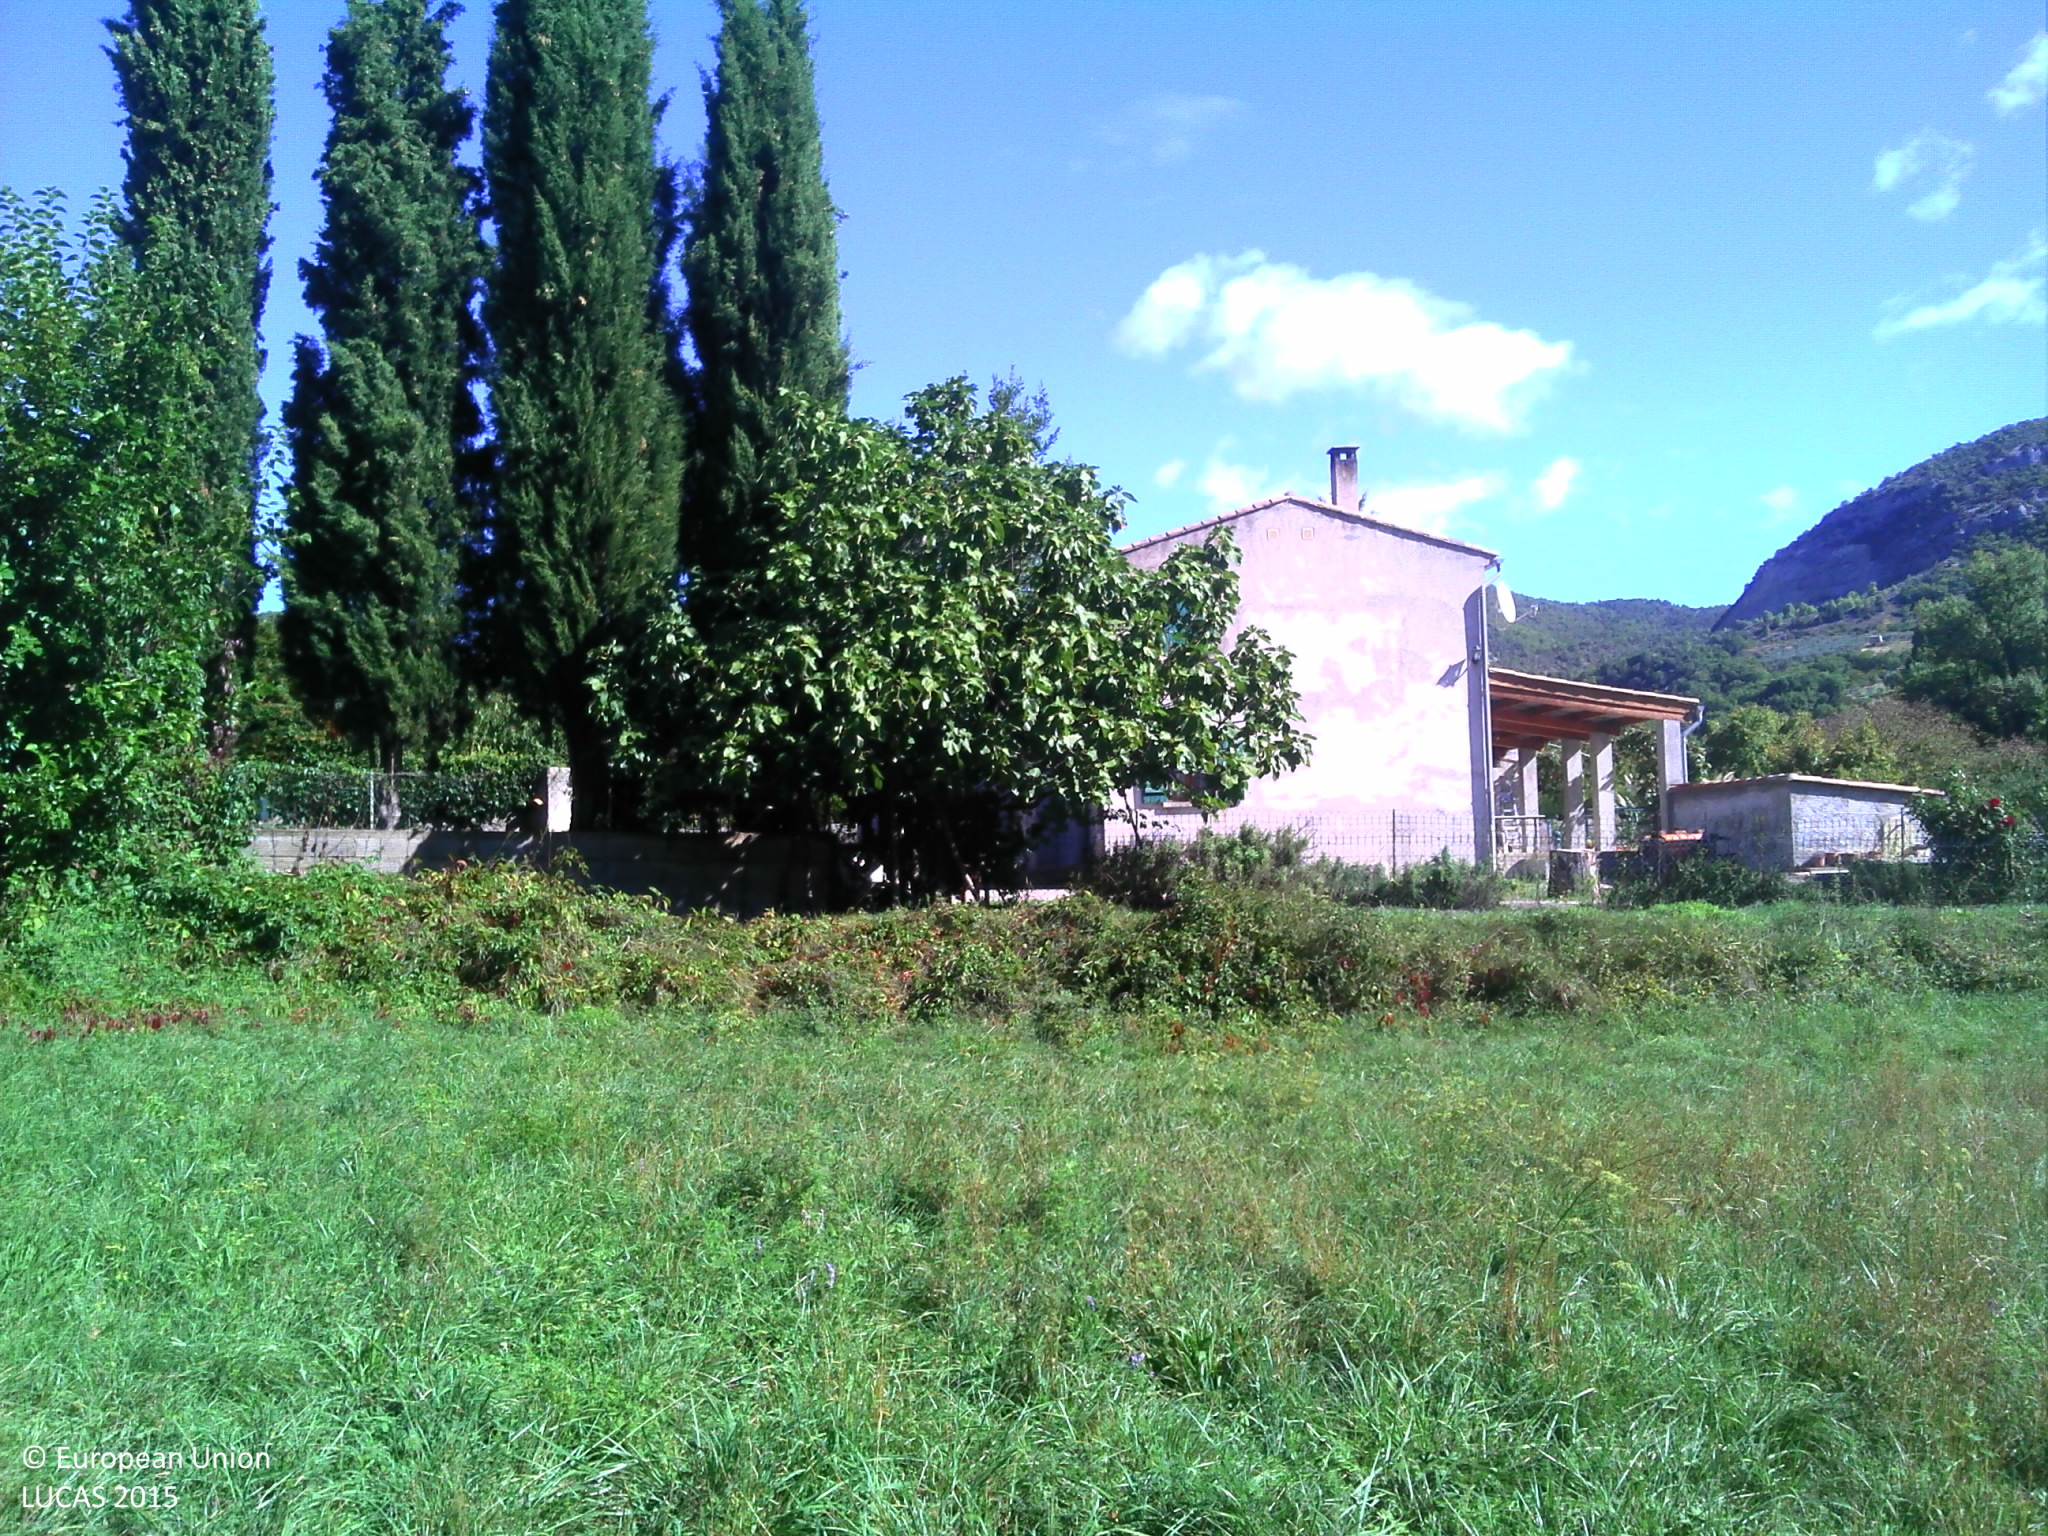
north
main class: Grassland
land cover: Grassland without tree/shrub cover
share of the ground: > 75 %
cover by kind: herbaceous plants 100 %
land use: Agriculture (excluding fallow land and kitchen gardens)
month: November
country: FR
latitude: 44.4020
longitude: 5.1983
